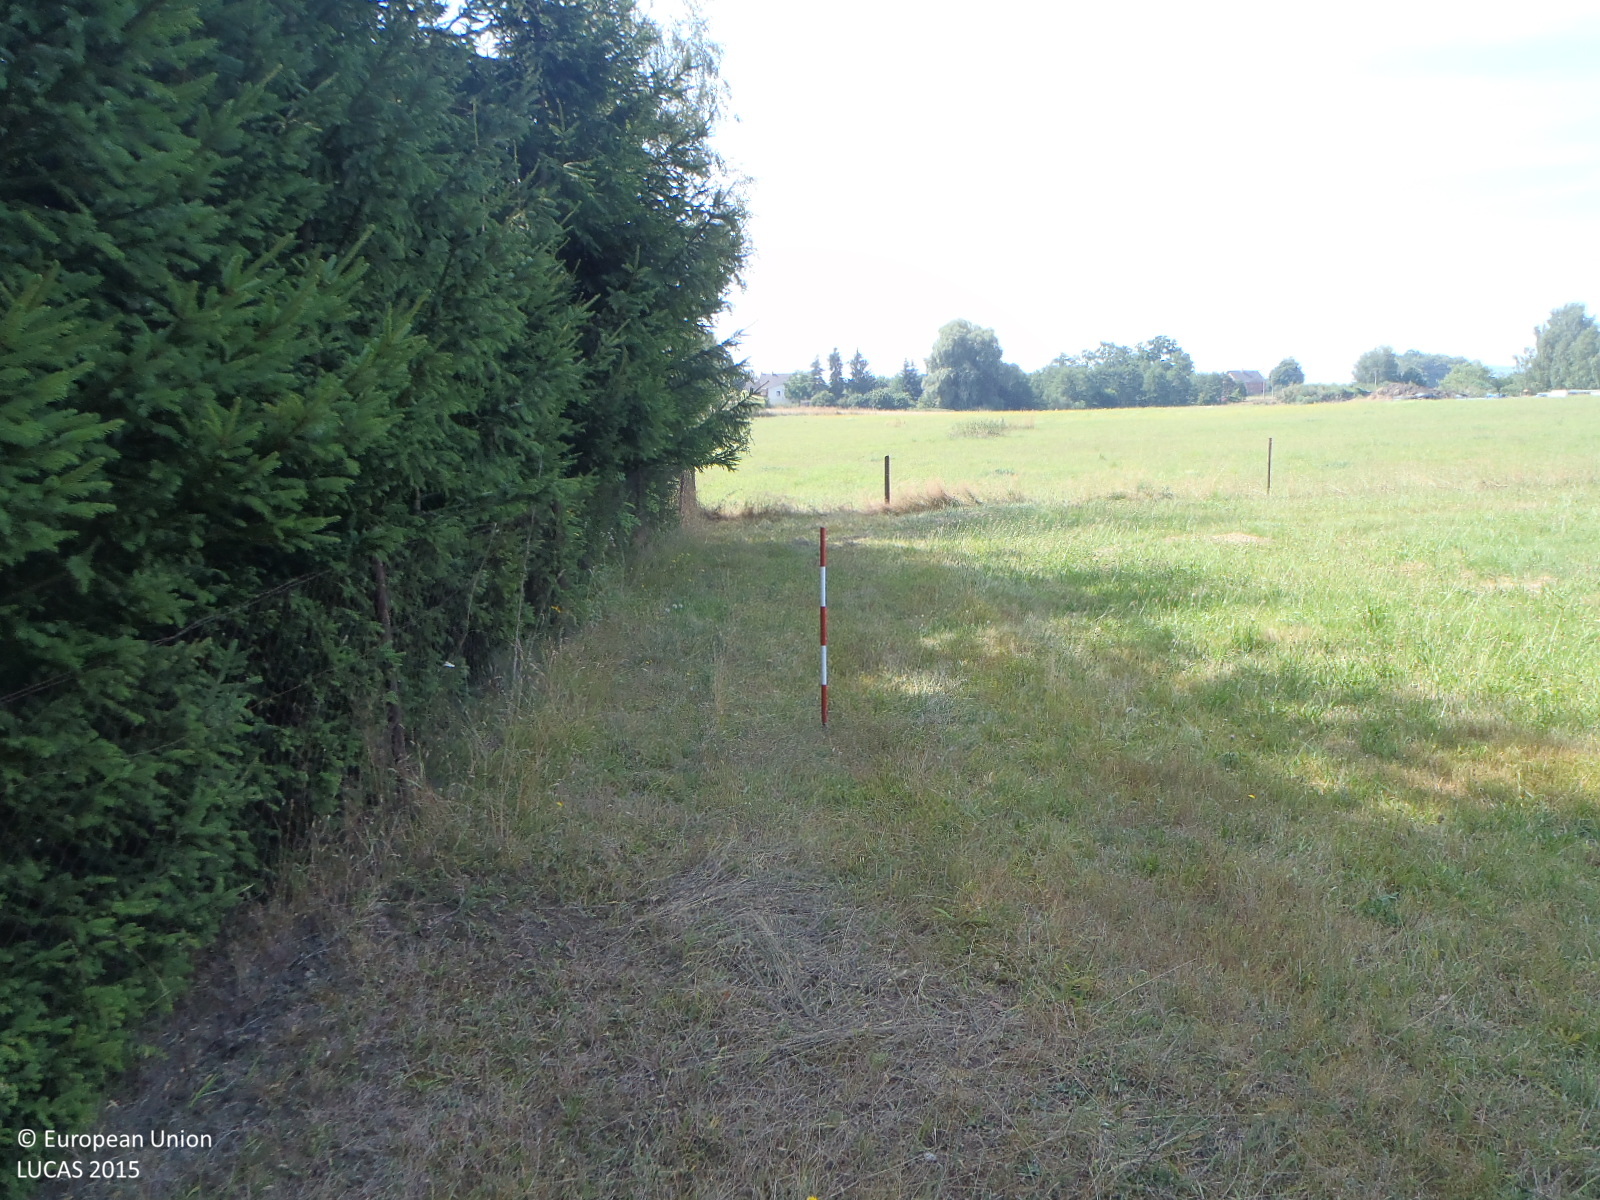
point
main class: Grassland
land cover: Grassland without tree/shrub cover
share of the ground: > 75 %
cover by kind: herbaceous plants 100 %
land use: Agriculture (excluding fallow land and kitchen gardens)
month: August
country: CZ
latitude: 50.7238
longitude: 14.5491
